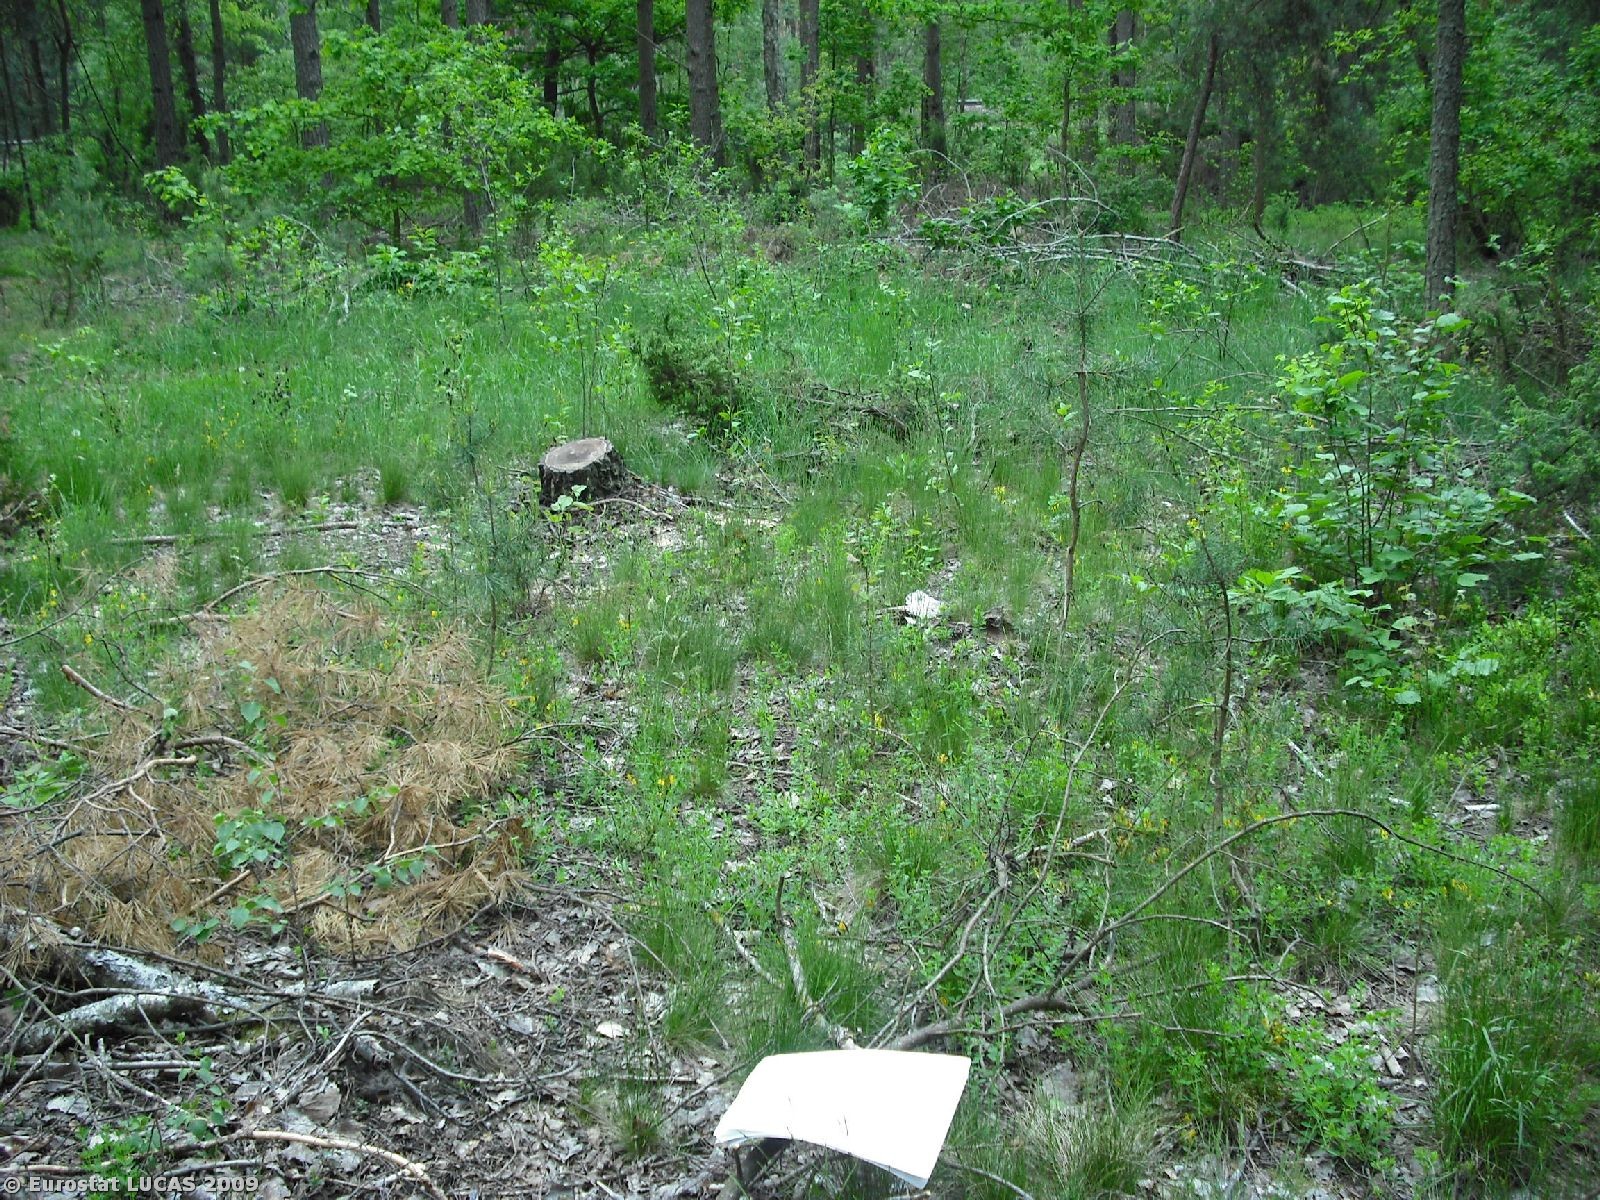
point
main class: Woodland
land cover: Mixed woodland
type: hemiboreal forest and nemoral coniferous forest and mixed broadleaved-coniferous forest
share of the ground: 50 - 75 %
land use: Forestry
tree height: > 5 m
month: May
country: PL
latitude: 52.8313
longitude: 22.4289
